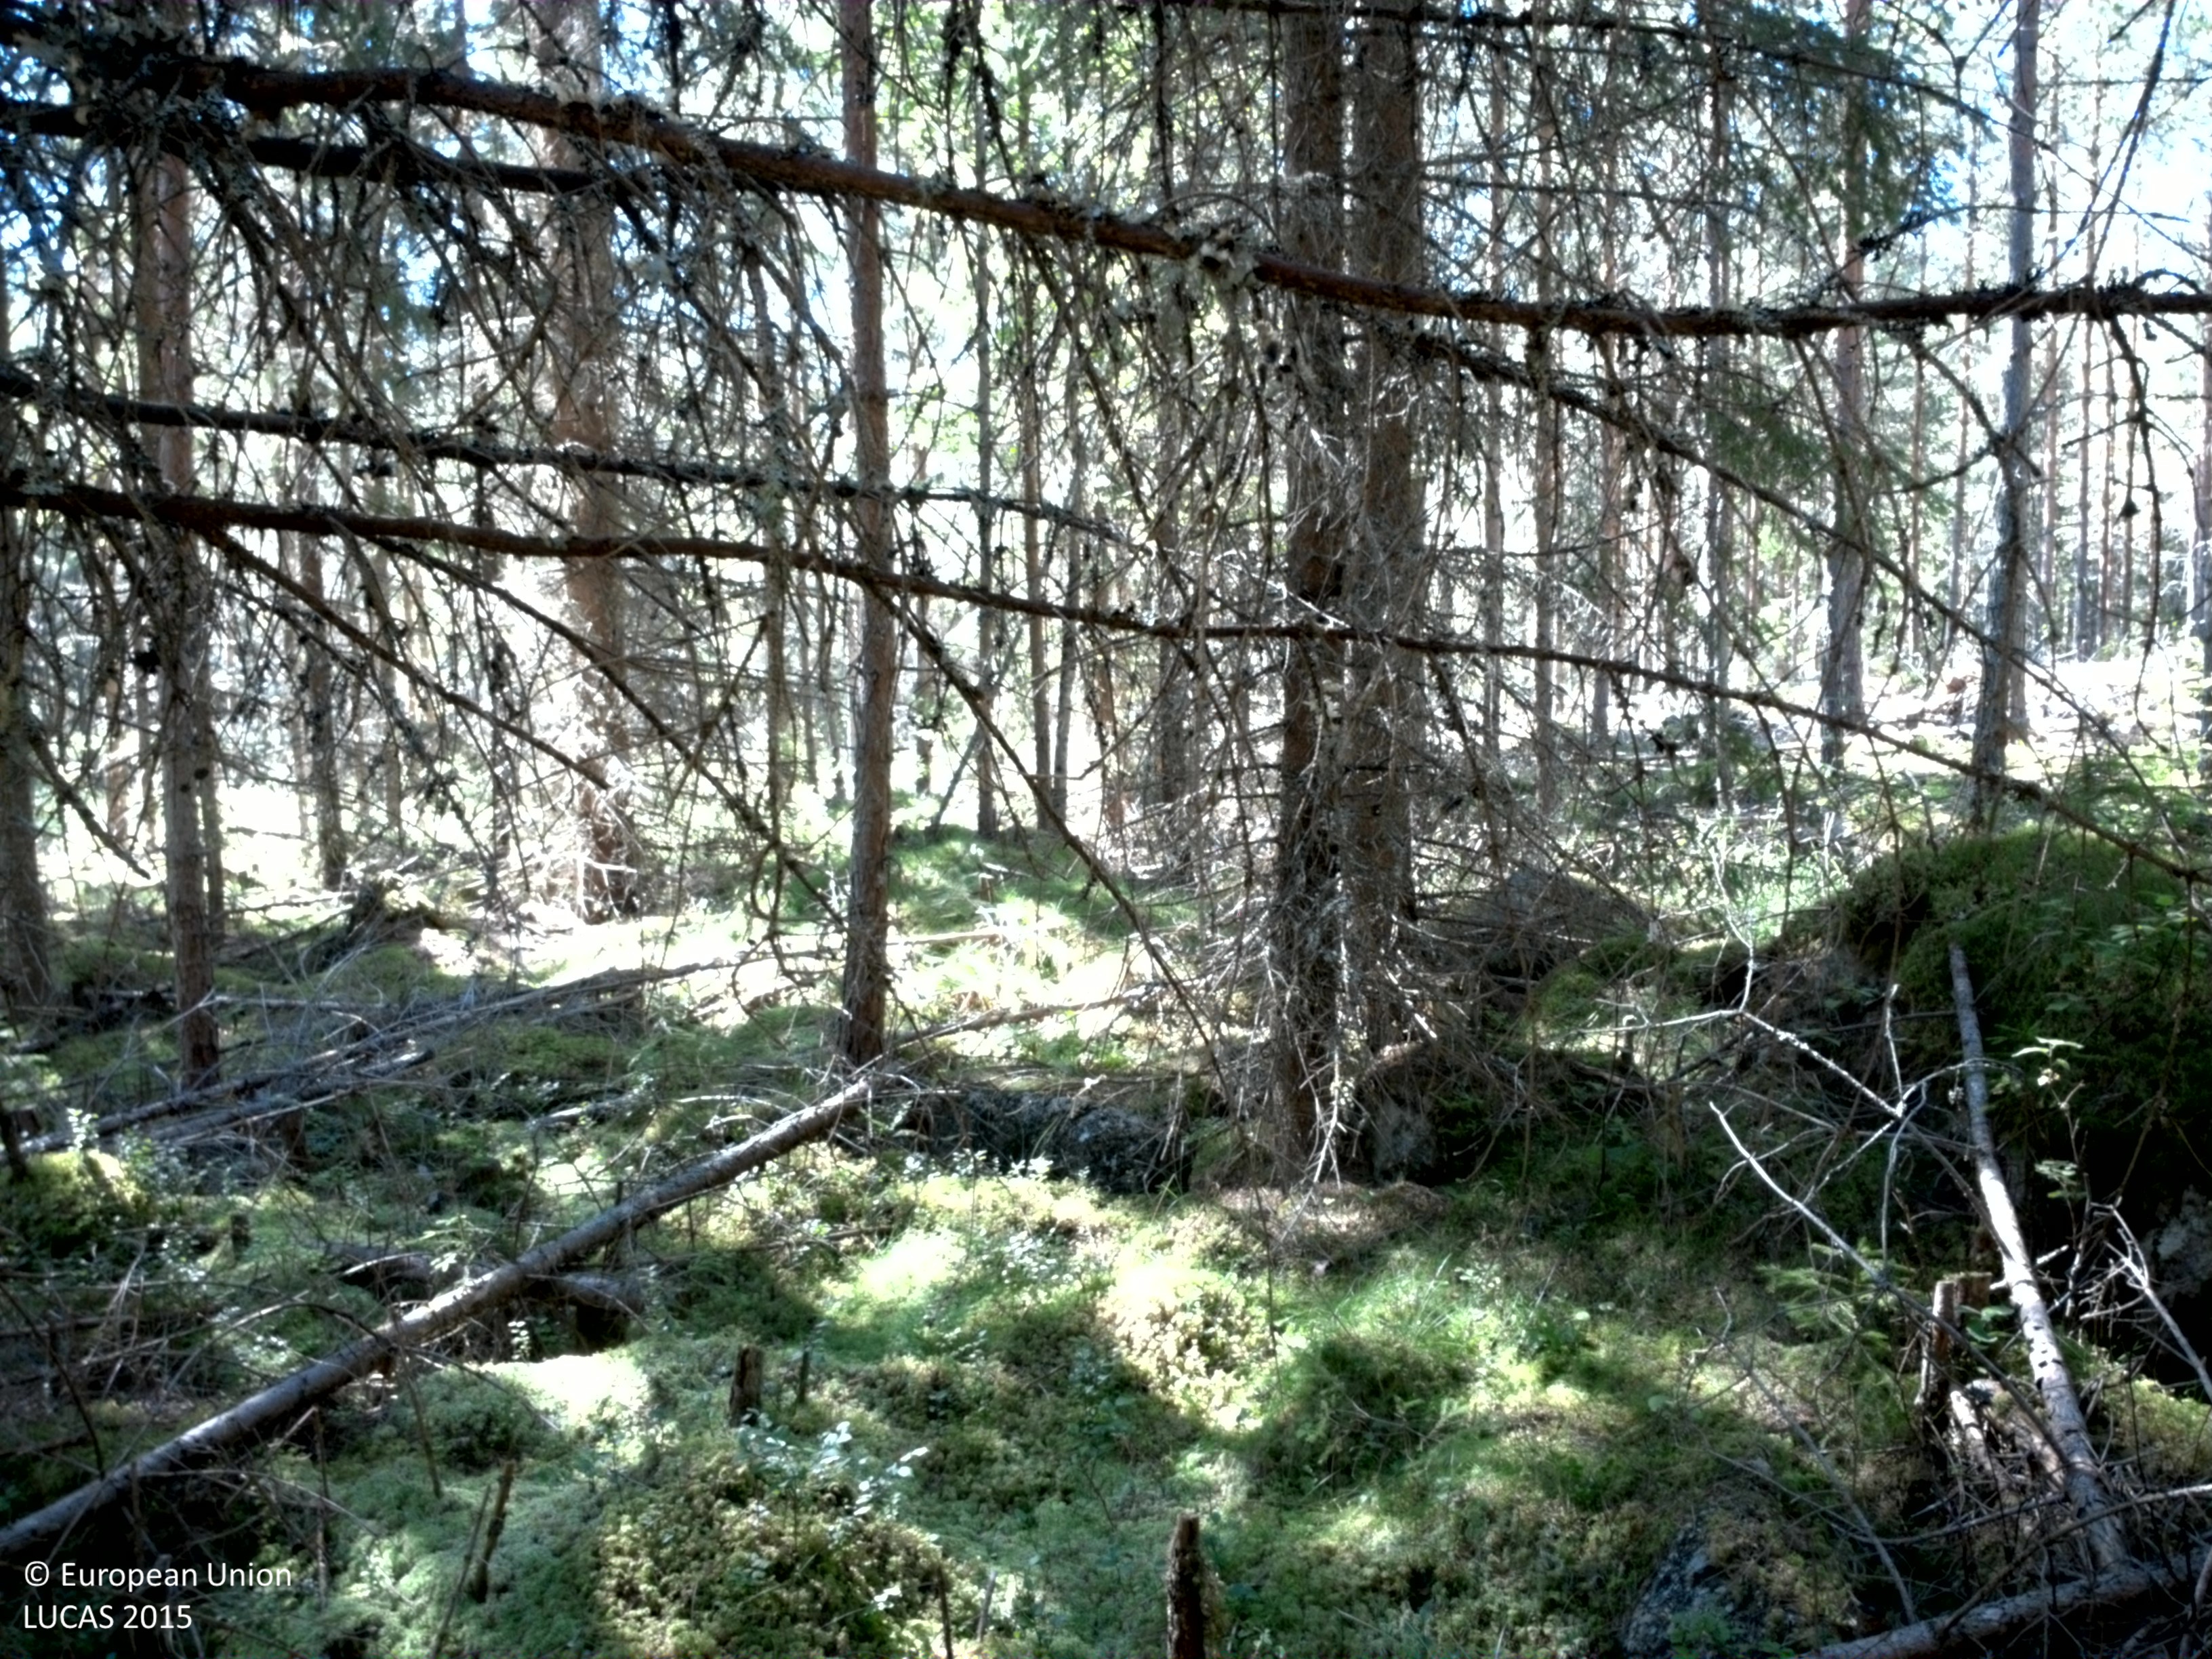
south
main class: Woodland
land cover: Spruce dominated coniferous woodland
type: boreal forest
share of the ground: 50 - 75 %
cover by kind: coniferous forest trees 60 %, lichens and mosses 30 %, shrubs 10 %
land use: Forestry
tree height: > 5 m
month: August
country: SE
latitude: 60.0824
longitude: 13.5316
